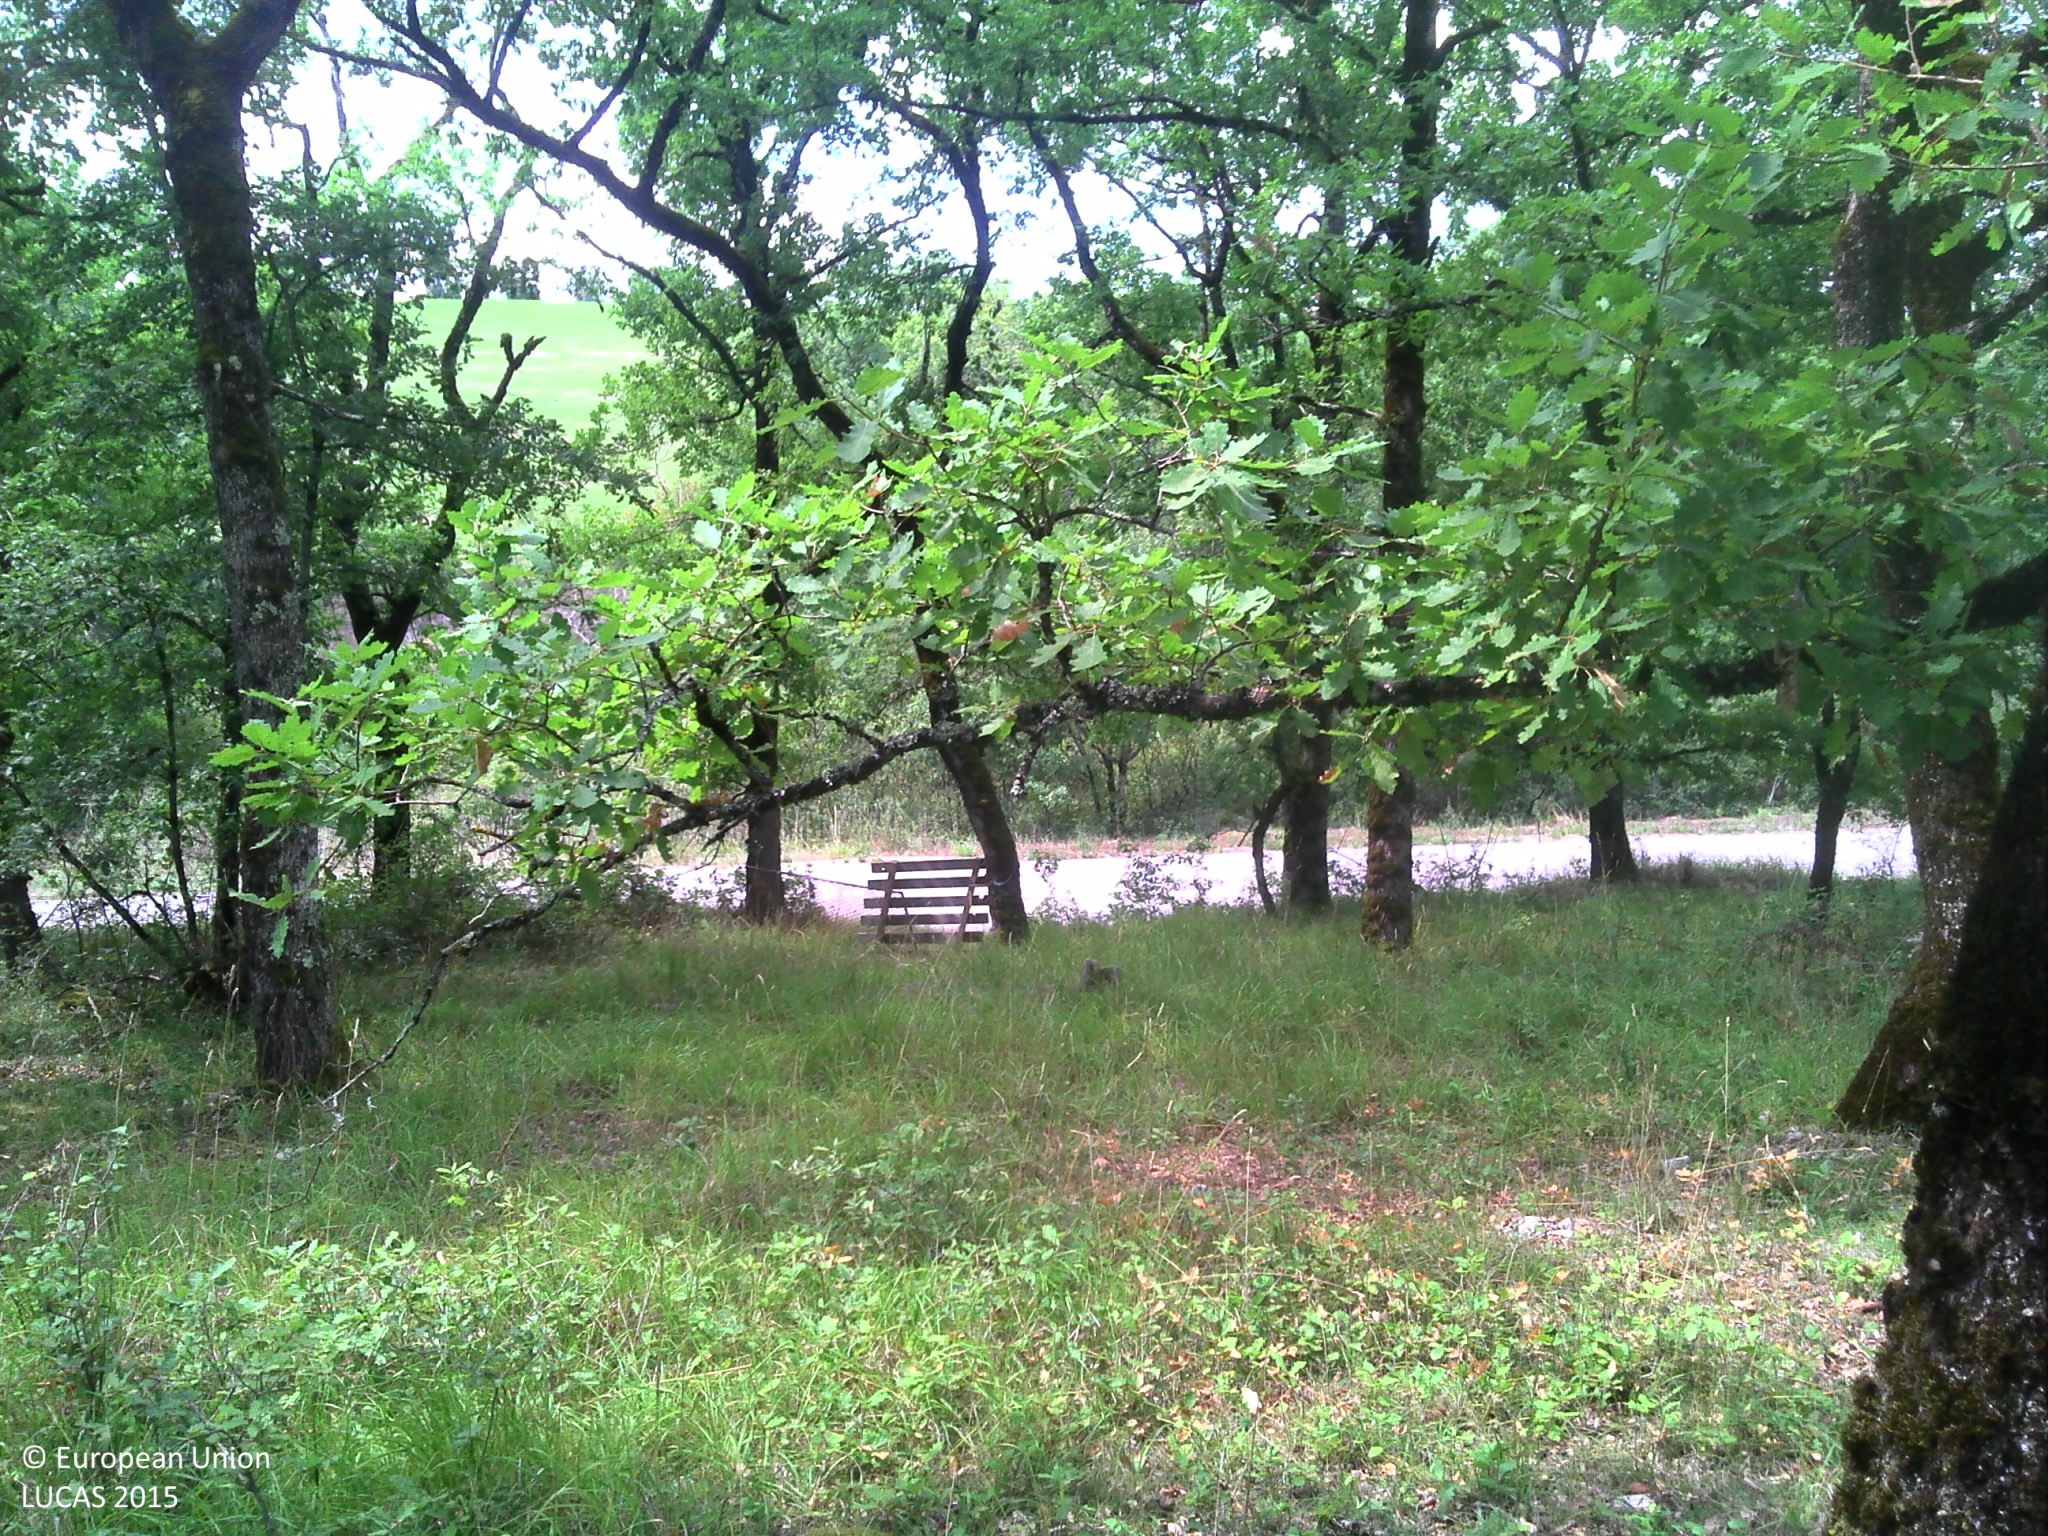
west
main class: Woodland
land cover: Broadleaved woodland
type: thermophilous deciduous forest
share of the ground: > 75 %
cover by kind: broadleaved forest trees 80 %, shrubs 10 %, herbaceous plants 10 %
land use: Forestry
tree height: > 5 m
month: August
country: FR
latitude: 44.8579
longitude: 1.7851
